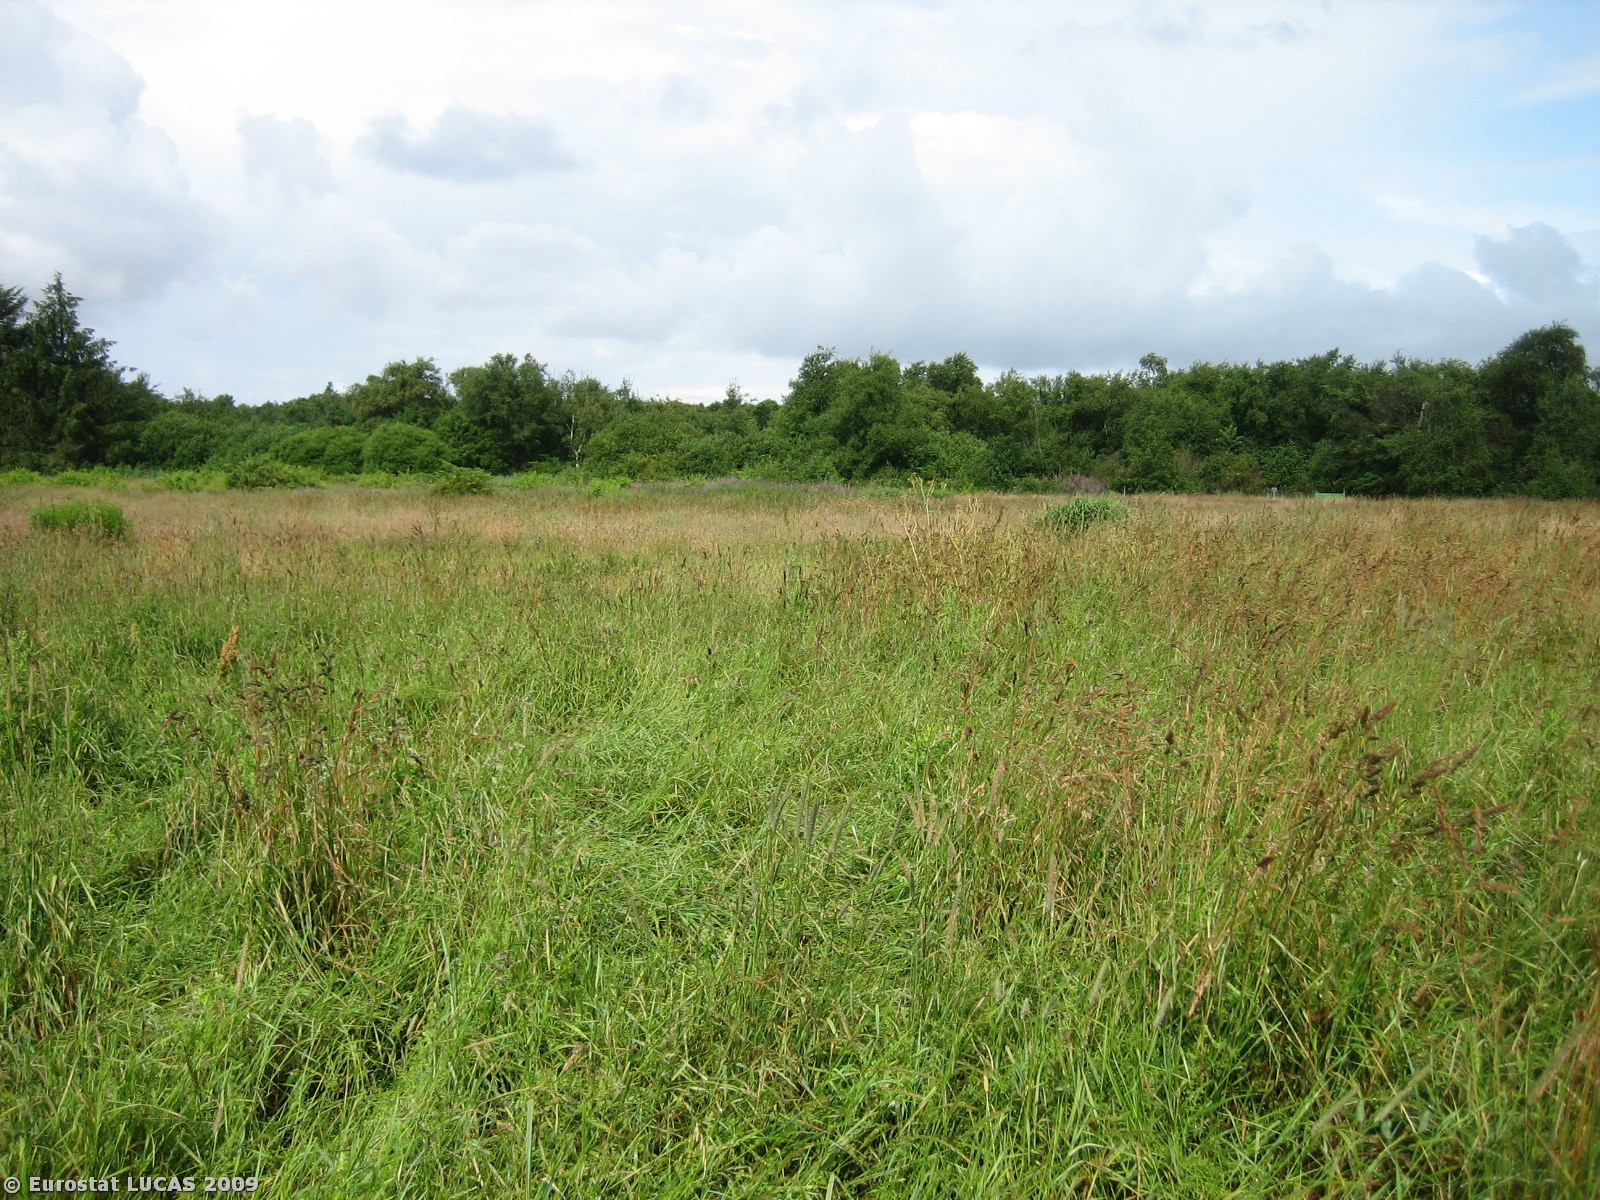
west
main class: Grassland
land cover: Grassland without tree/shrub cover
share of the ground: > 75 %
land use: Amenities, museums, leisure
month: July
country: DK
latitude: 55.5130
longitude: 8.4336
